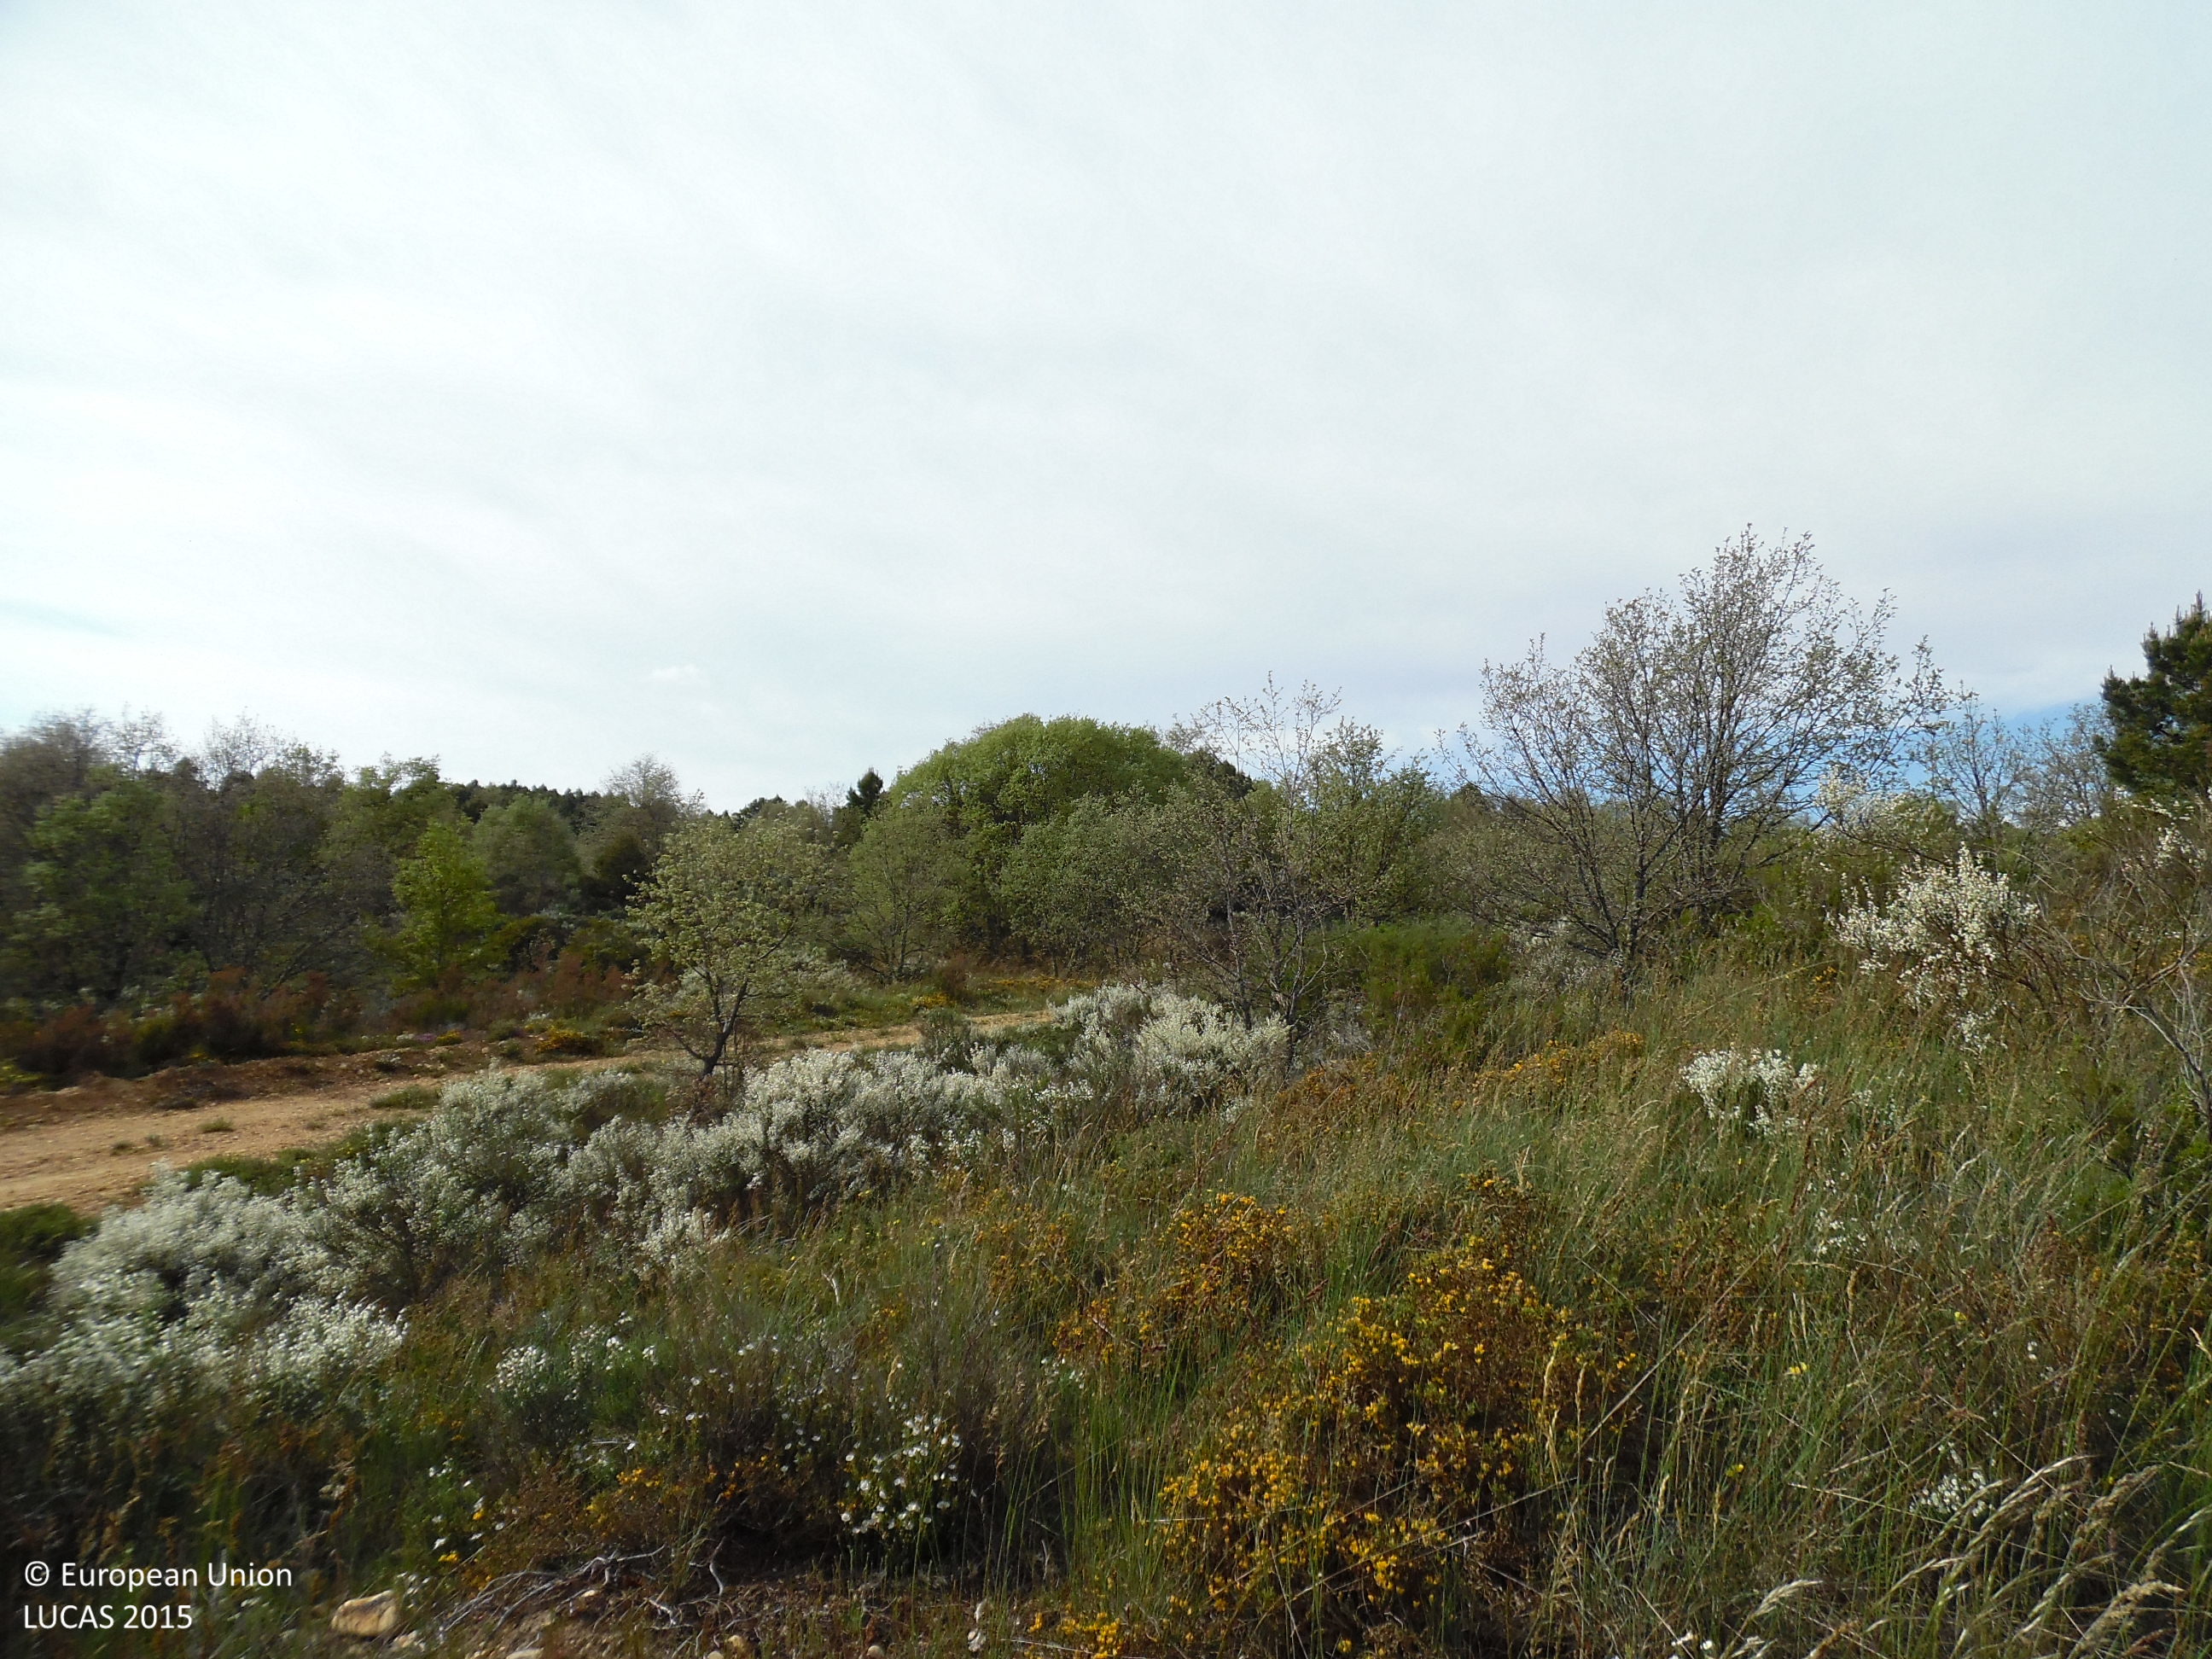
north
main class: Shrubland
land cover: Shrubland without tree cover
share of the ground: > 75 %
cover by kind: shrubs 100 %
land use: Semi-natural and natural areas not in use
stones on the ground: < 10 %
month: May
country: ES
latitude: 42.6037
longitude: -6.1128
